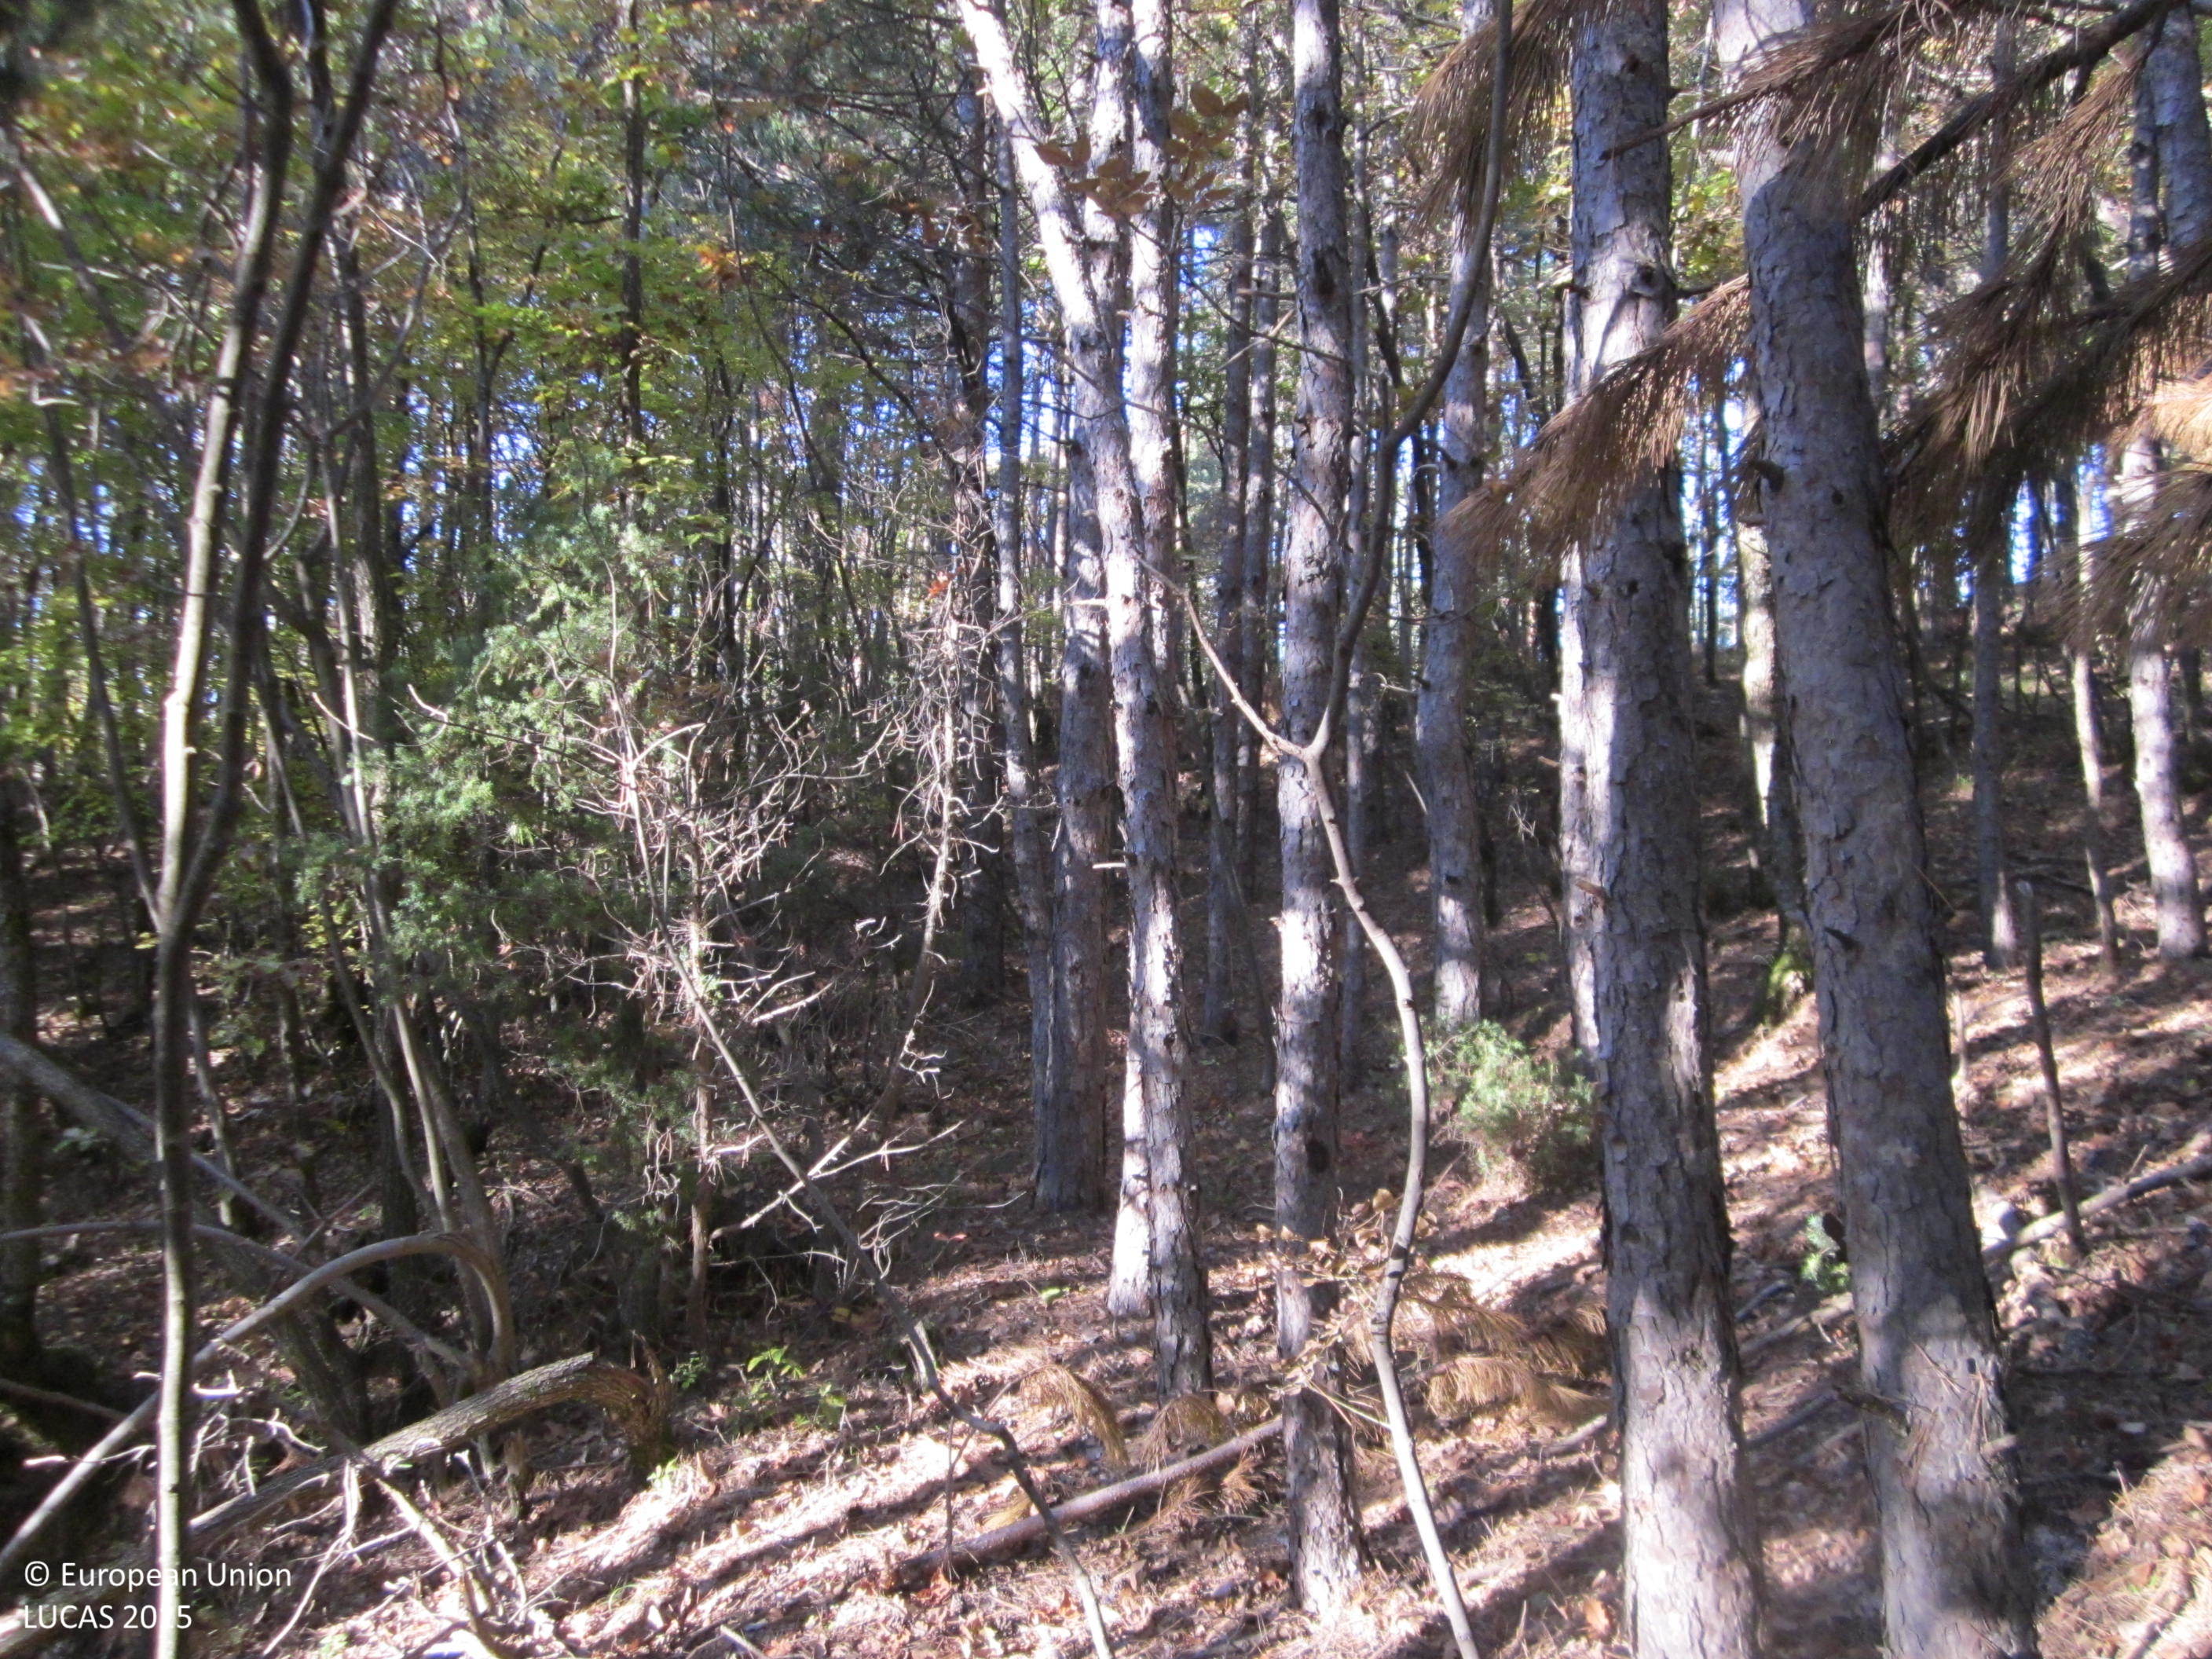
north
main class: Woodland
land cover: Pine dominated mixed woodland
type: hemiboreal forest and nemoral coniferous forest and mixed broadleaved-coniferous forest
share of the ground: > 75 %
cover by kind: coniferous forest trees 60 %, broadleaved forest trees 20 %, unconsolidated bare surface 15 %, lichens and mosses 5 %
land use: Forestry
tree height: > 5 m
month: November
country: BG
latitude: 41.5621
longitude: 25.7352
